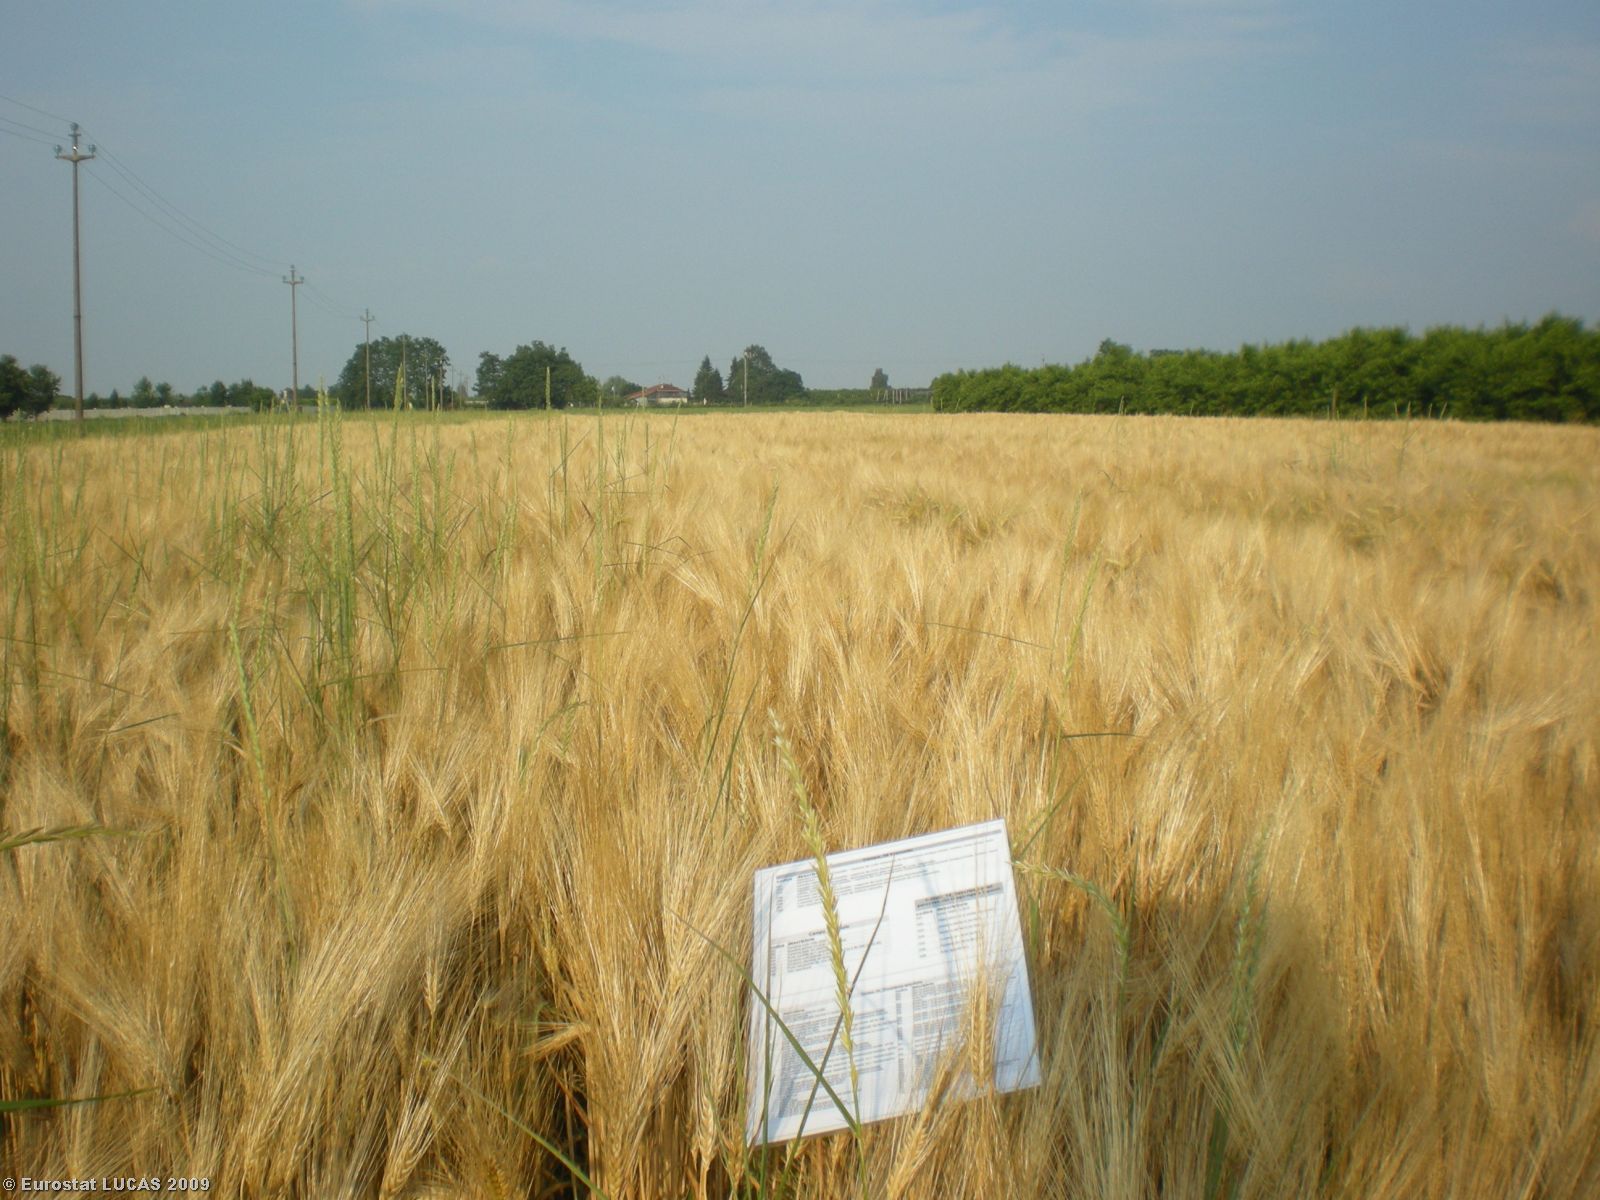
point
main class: Cropland
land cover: Barley
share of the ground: > 75 %
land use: Agriculture (excluding fallow land and kitchen gardens)
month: June
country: IT
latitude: 44.6787
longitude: 7.3936
